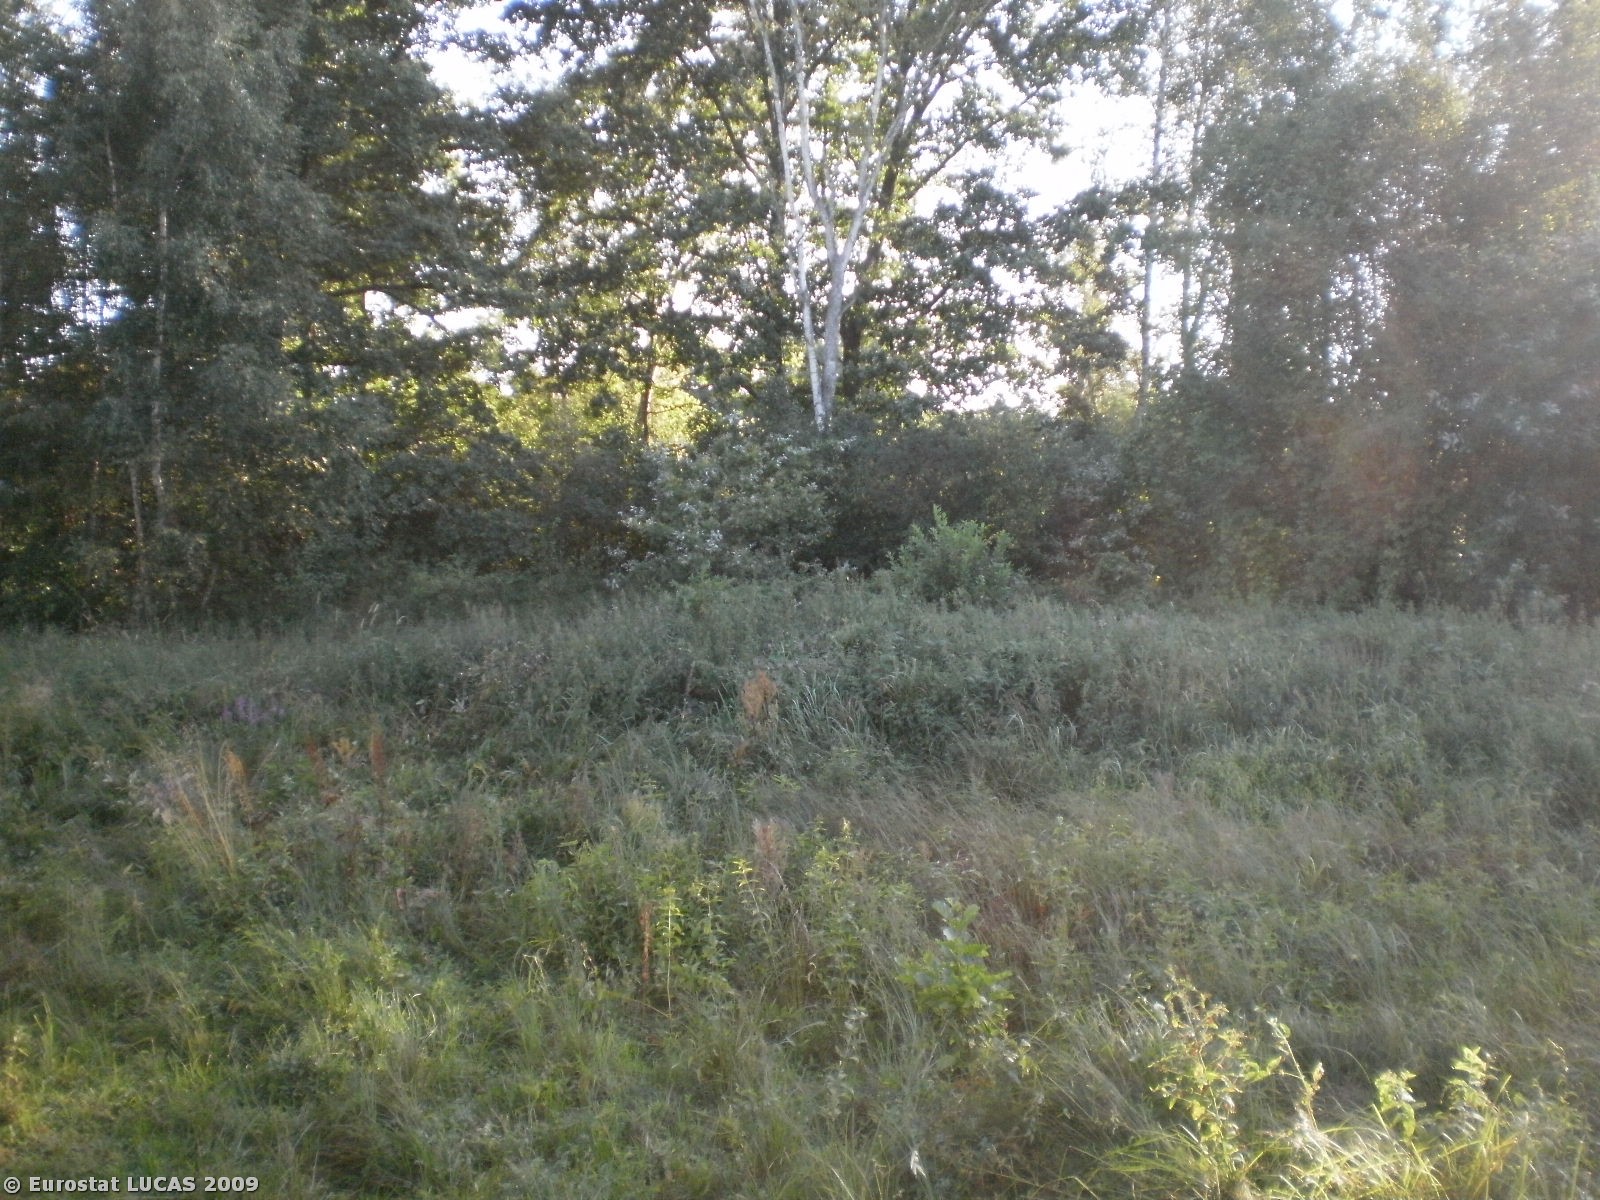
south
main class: Grassland
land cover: Grassland with sparse tree/shrub cover
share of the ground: > 75 %
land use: Agriculture (excluding fallow land and kitchen gardens)
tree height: < 5 m
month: August
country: PL
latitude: 53.2509
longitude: 21.8812
